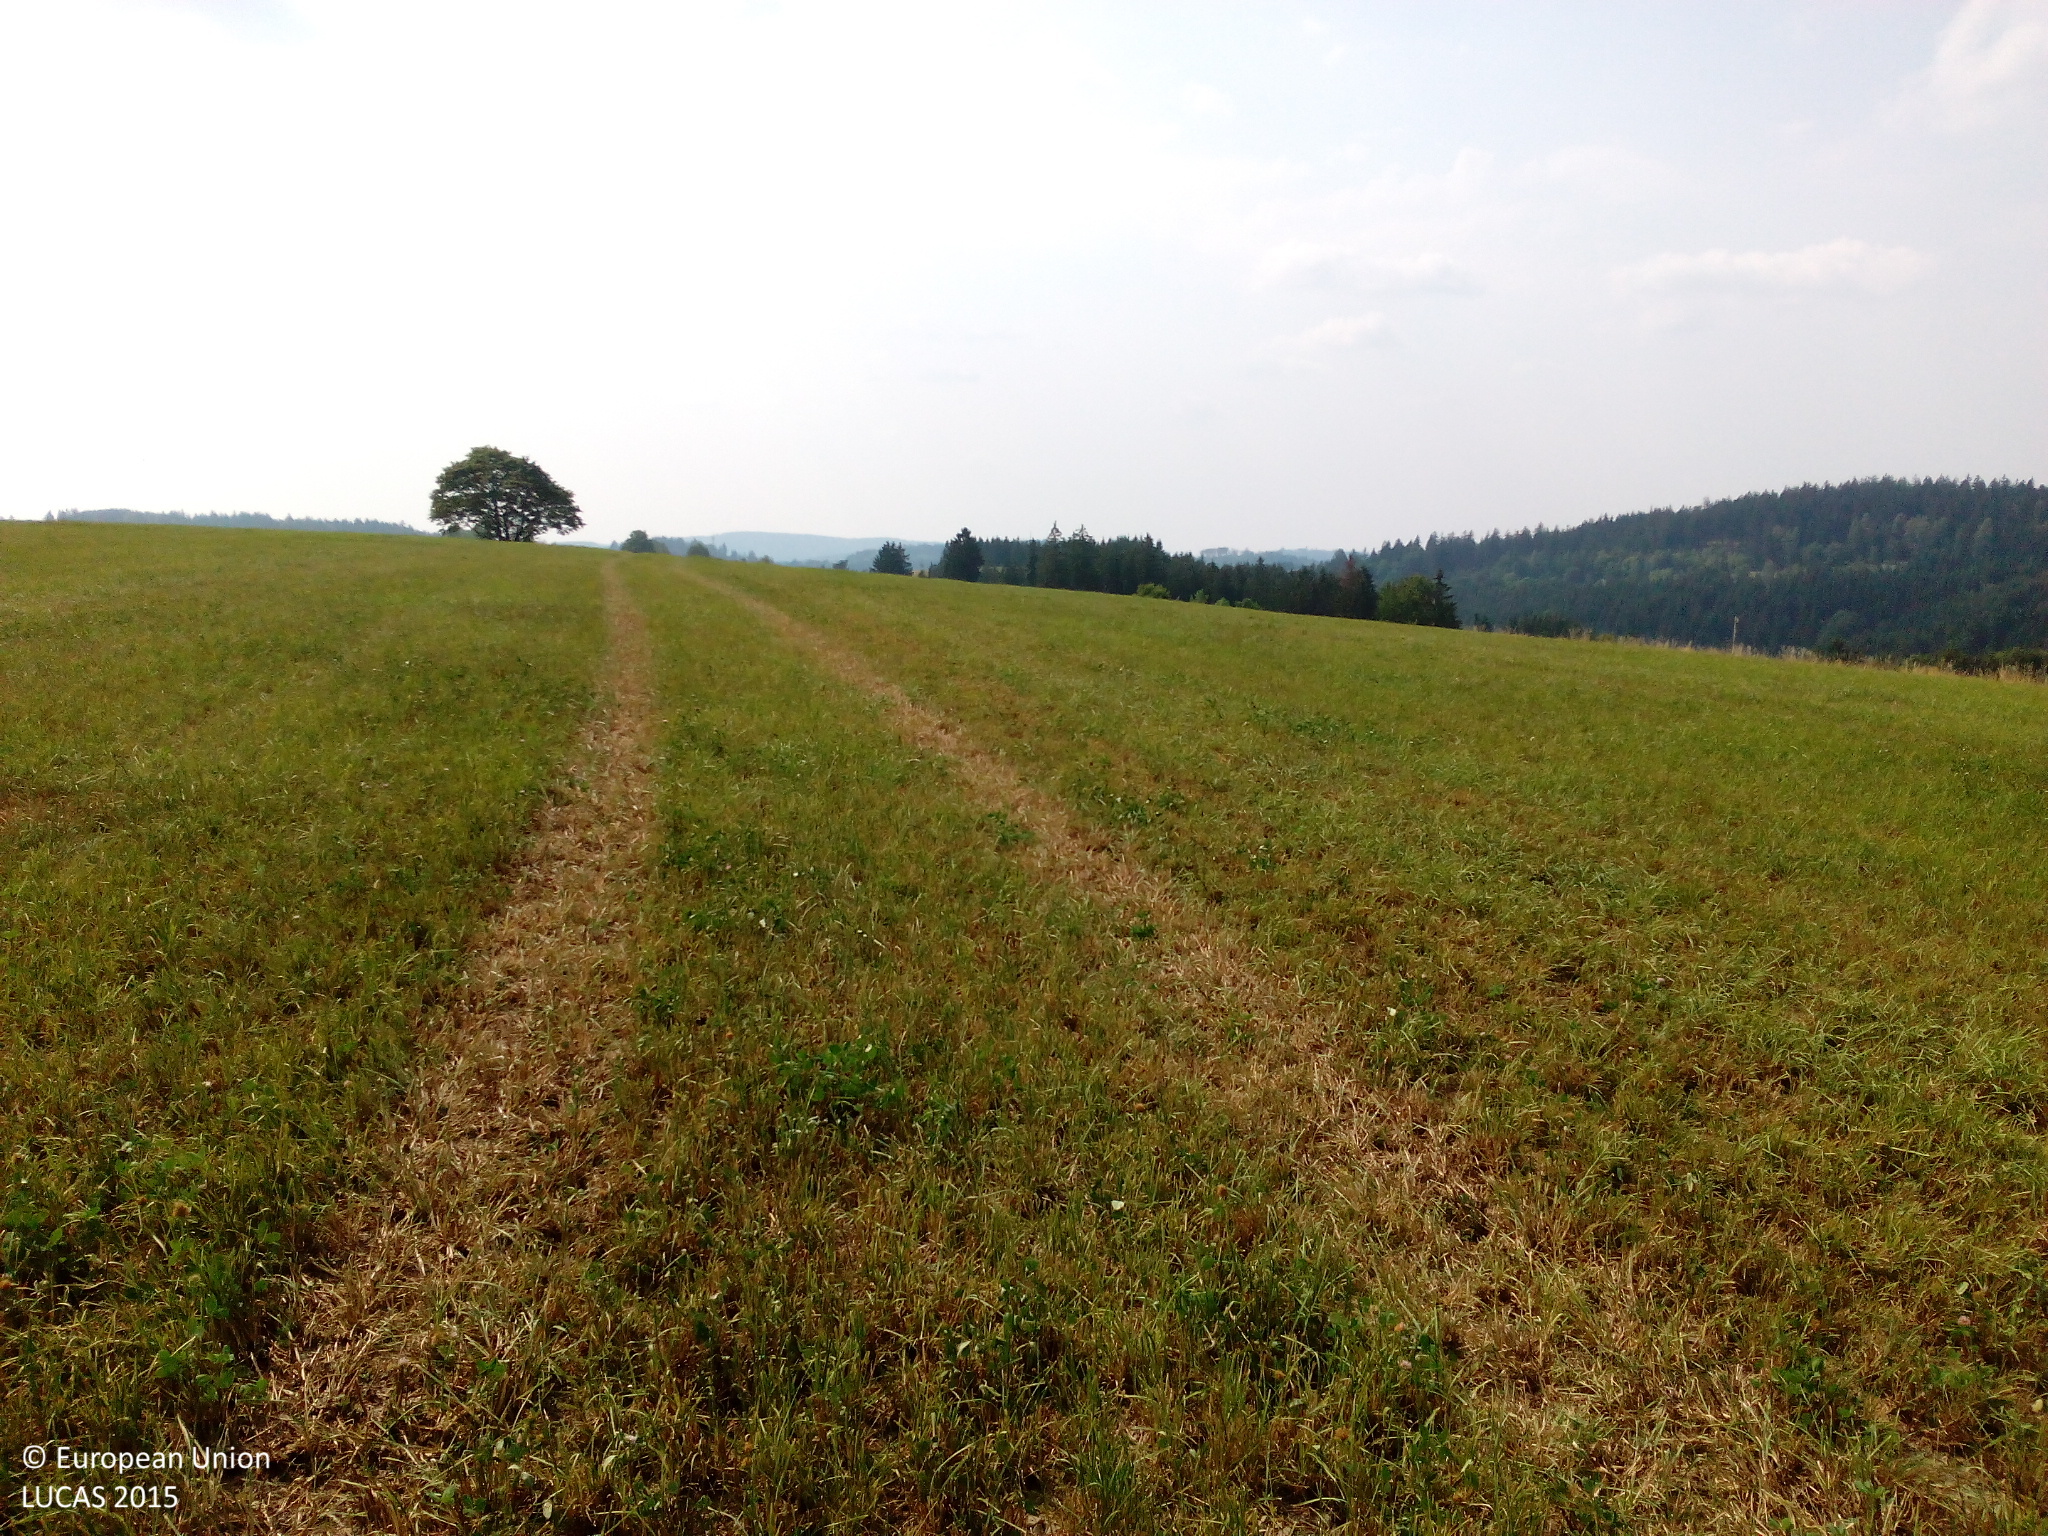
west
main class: Cropland
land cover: Temporary grasslands
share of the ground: 50 - 75 %
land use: Agriculture (excluding fallow land and kitchen gardens)
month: August
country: DE
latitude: 50.2632
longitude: 11.5848
